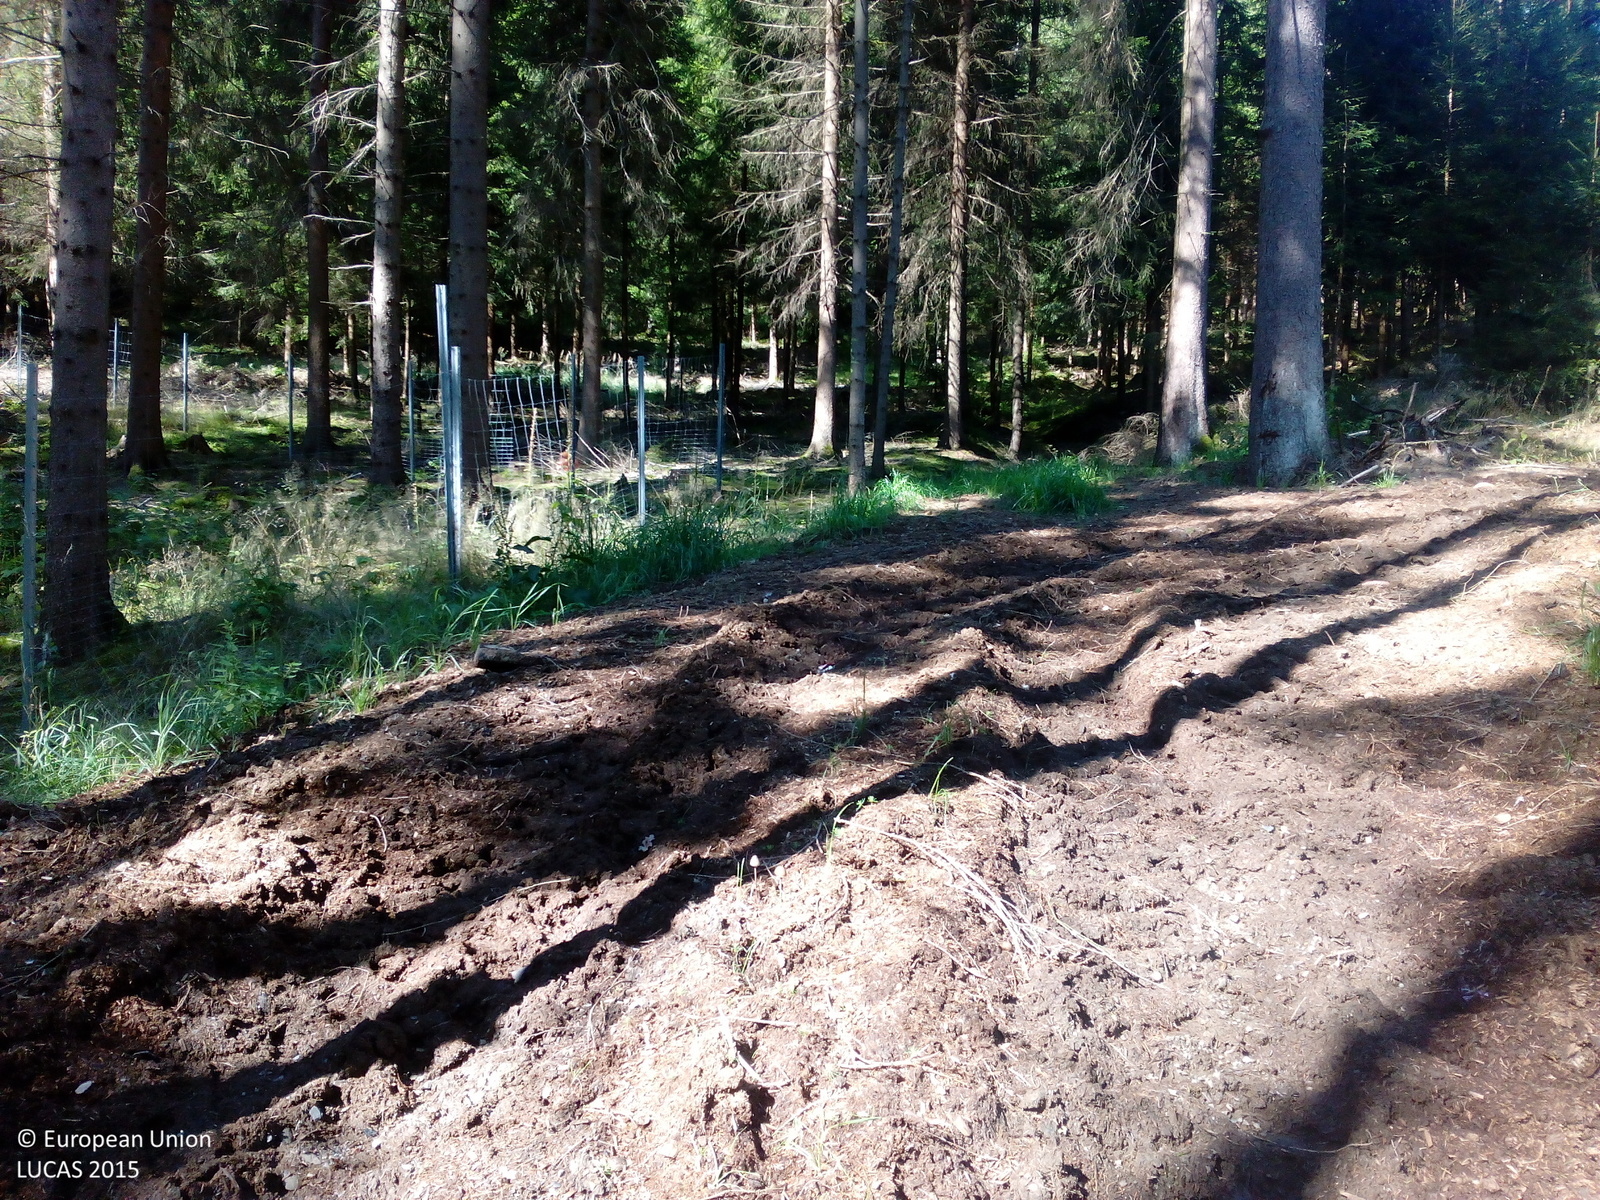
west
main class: Woodland
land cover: Spruce dominated coniferous woodland
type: hemiboreal forest and nemoral coniferous forest and mixed broadleaved-coniferous forest
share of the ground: 50 - 75 %
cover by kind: coniferous forest trees 60 %, unconsolidated bare surface 15 %, herbaceous plants 10 %, lichens and mosses 10 %, shrubs 5 %
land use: Forestry
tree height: > 5 m
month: August
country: DE
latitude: 50.3010
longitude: 11.4457
